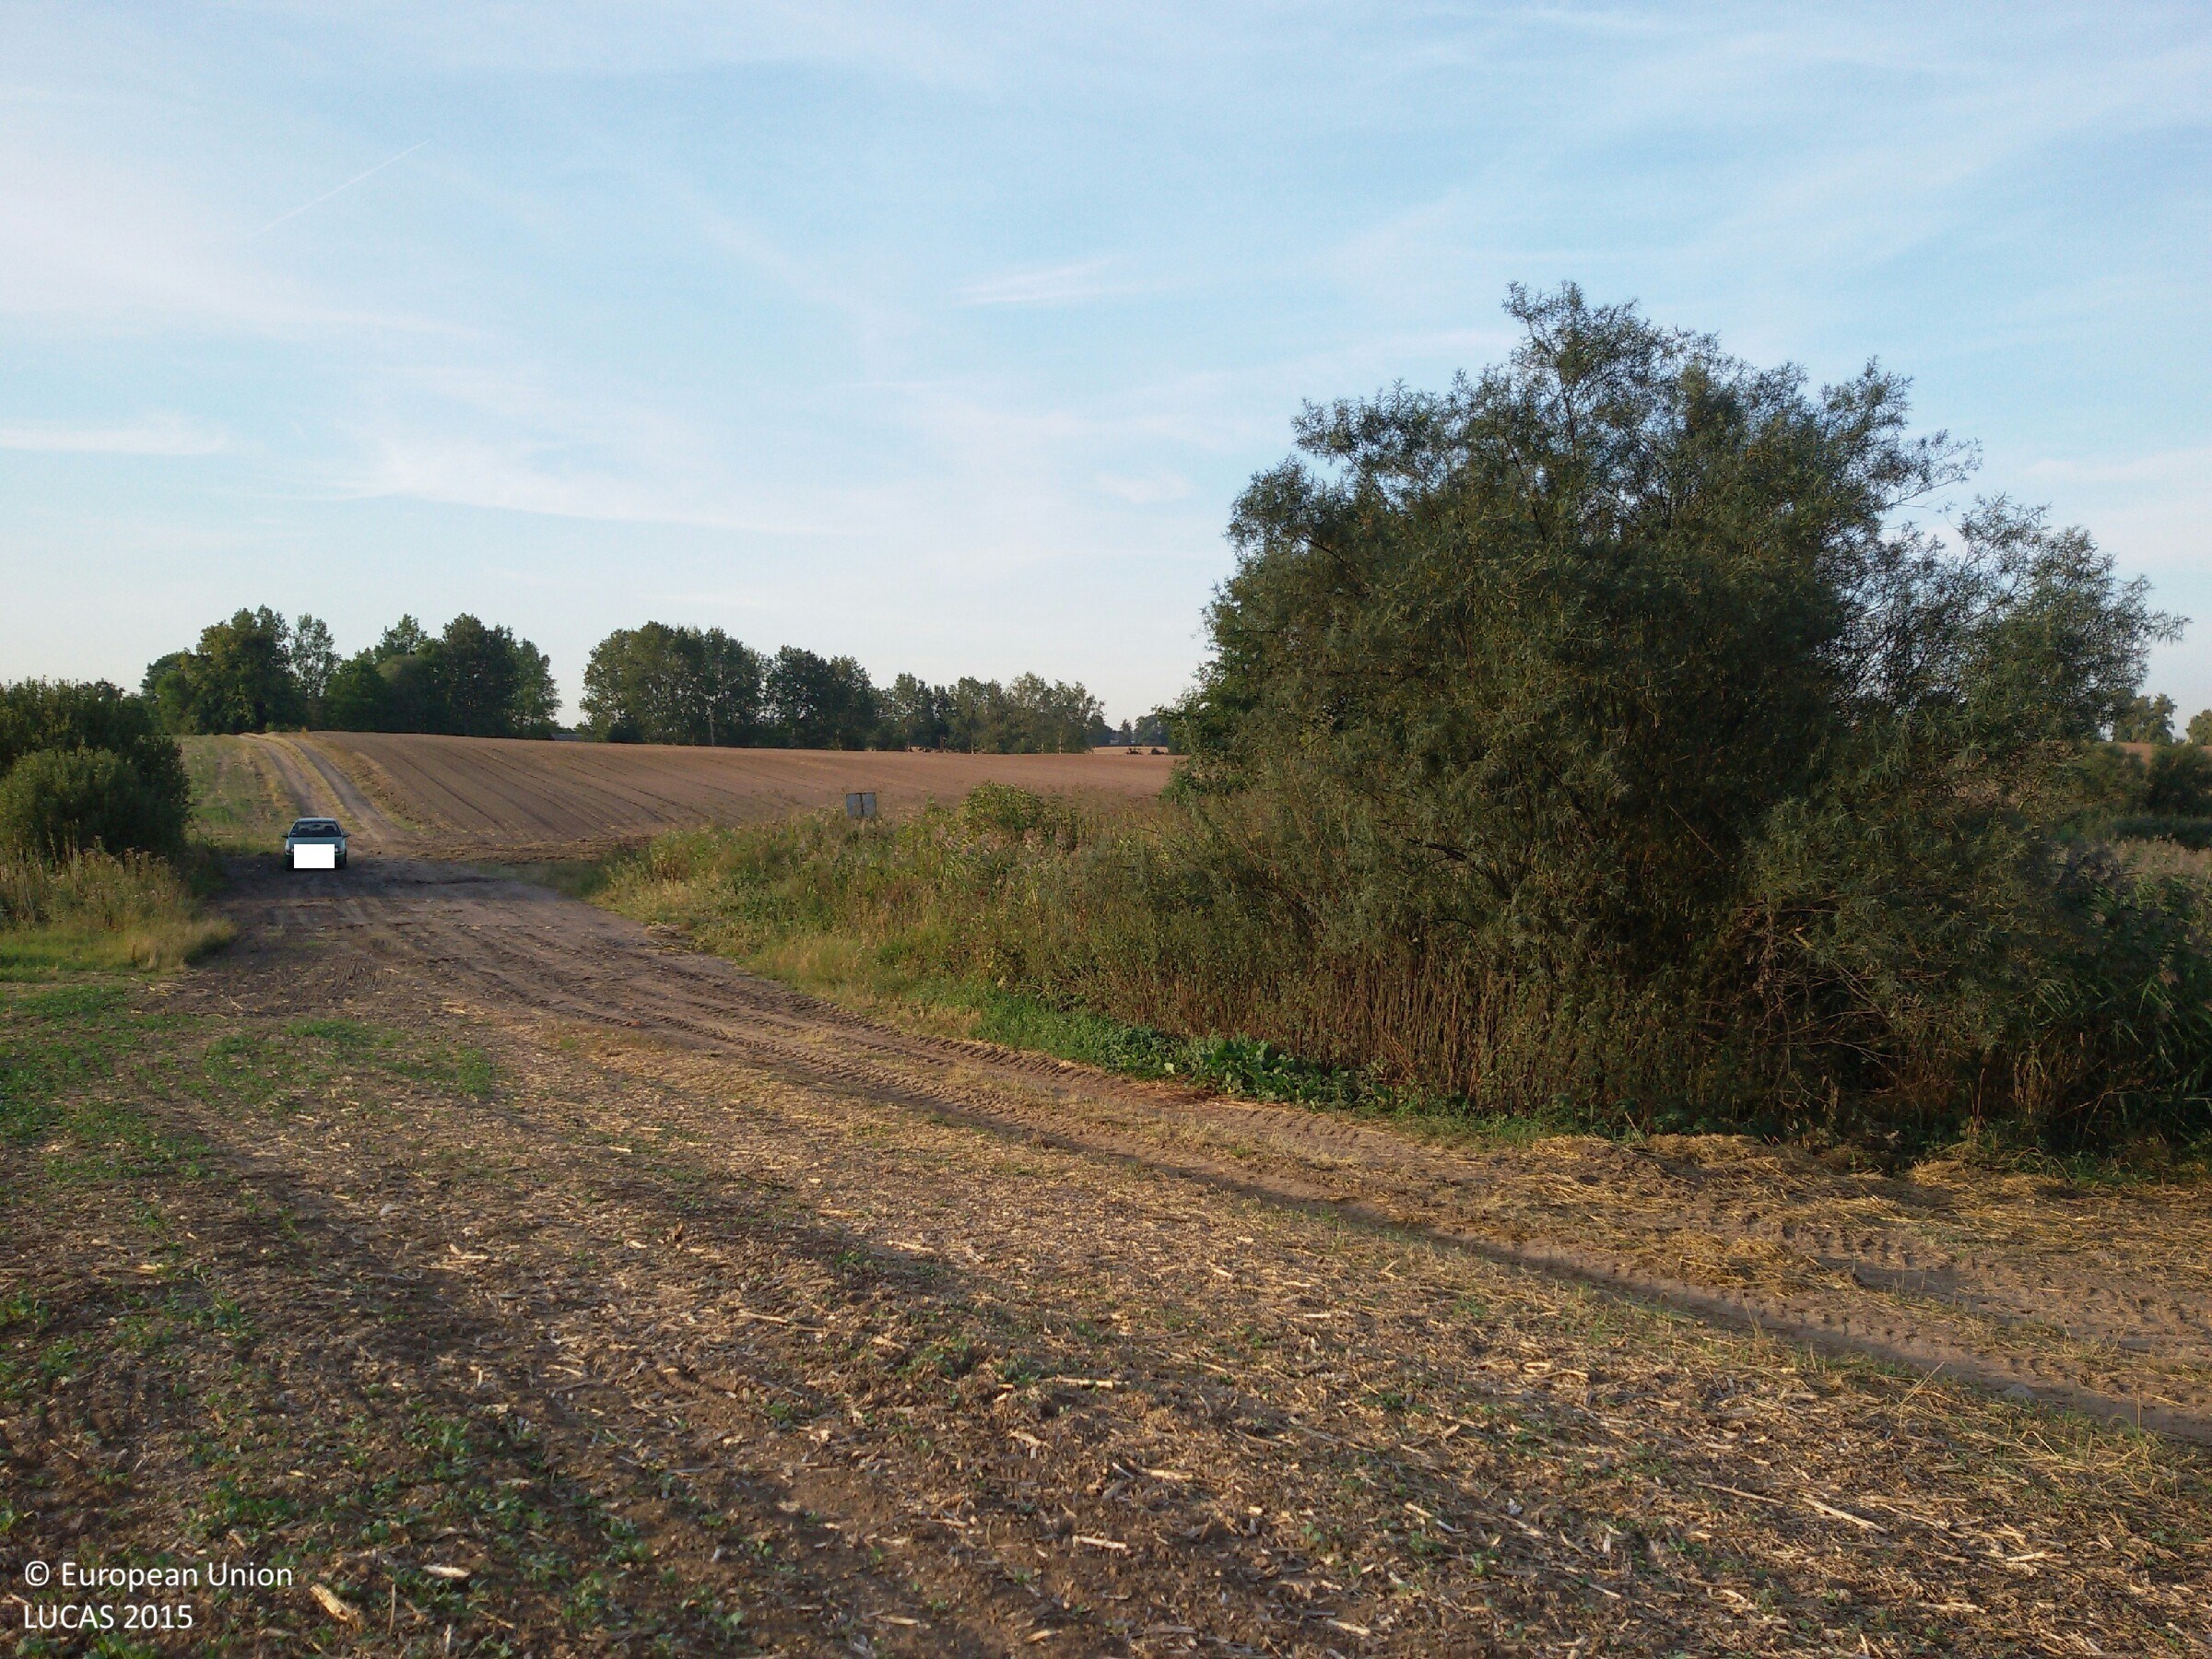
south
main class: Cropland
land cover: Rape and turnip rape
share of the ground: 25 - 50 %
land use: Agriculture (excluding fallow land and kitchen gardens)
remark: Harvested field
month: August
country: PL
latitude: 53.9459
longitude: 19.3337
